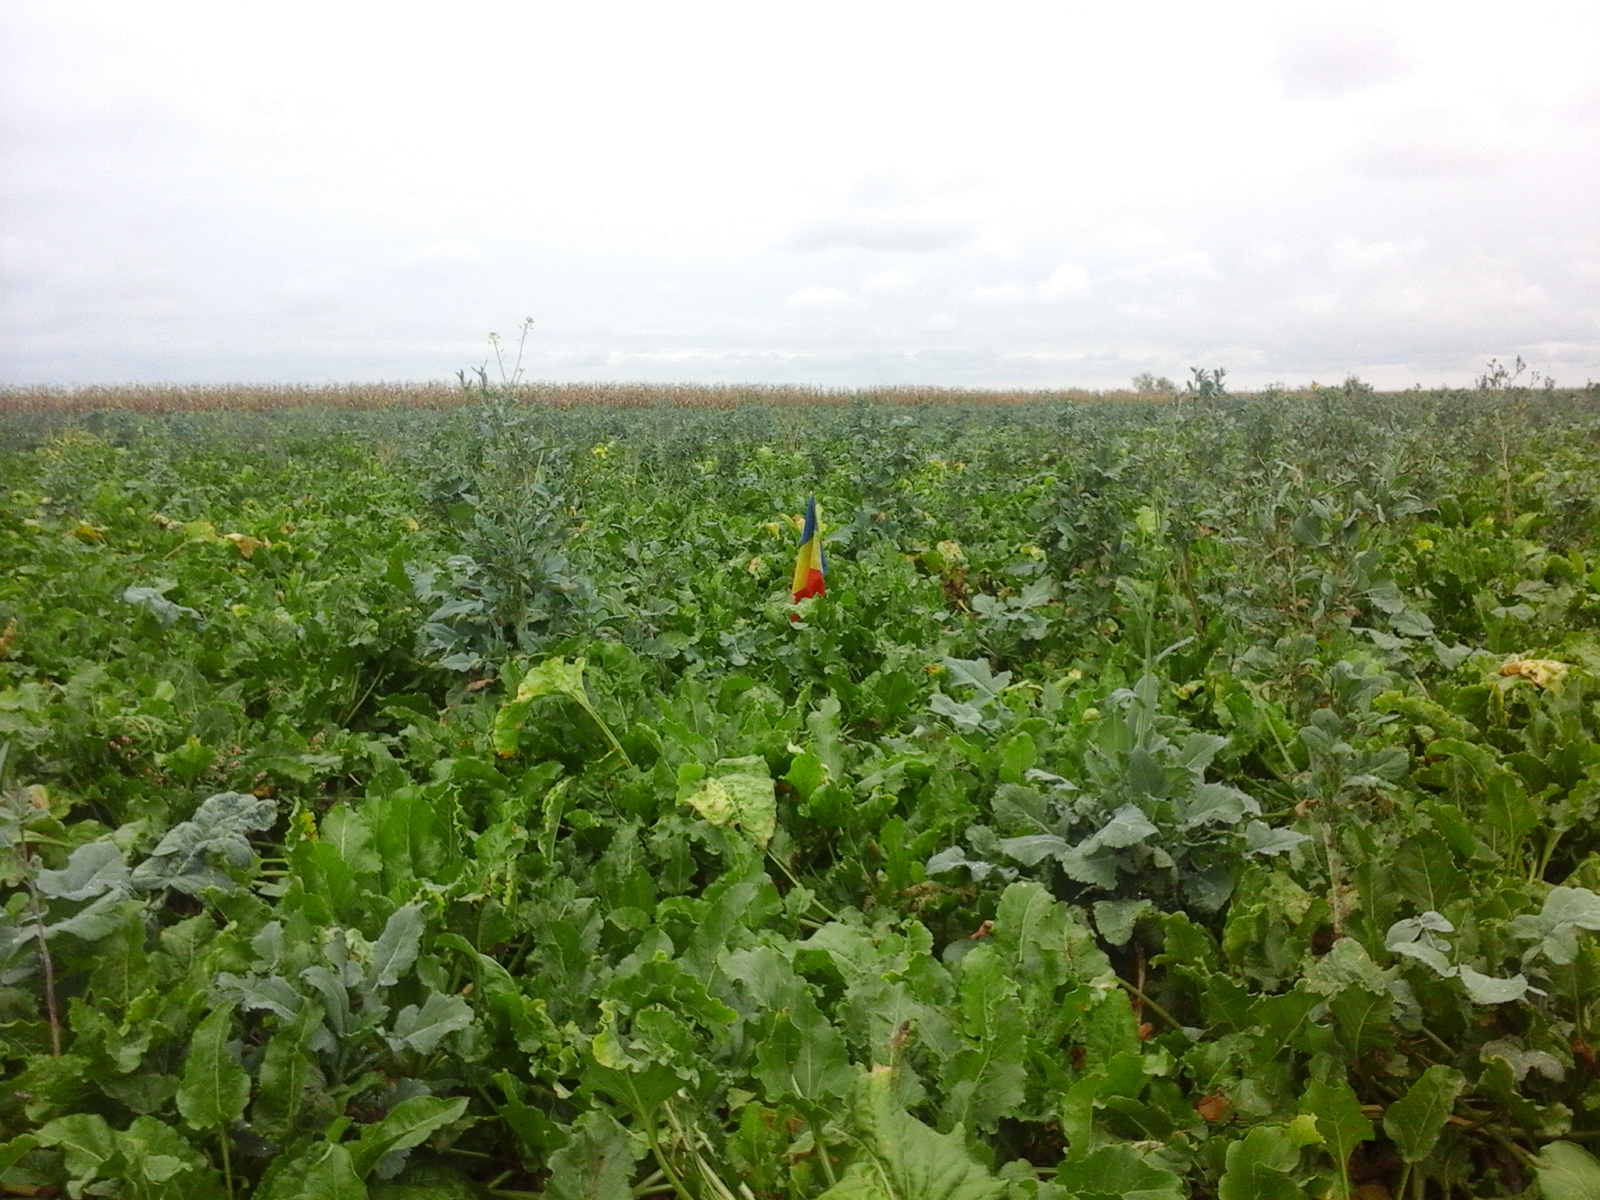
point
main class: Cropland
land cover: Sugar beet
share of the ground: > 75 %
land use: Agriculture (excluding fallow land and kitchen gardens)
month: September
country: RO
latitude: 47.1959
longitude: 21.8863
